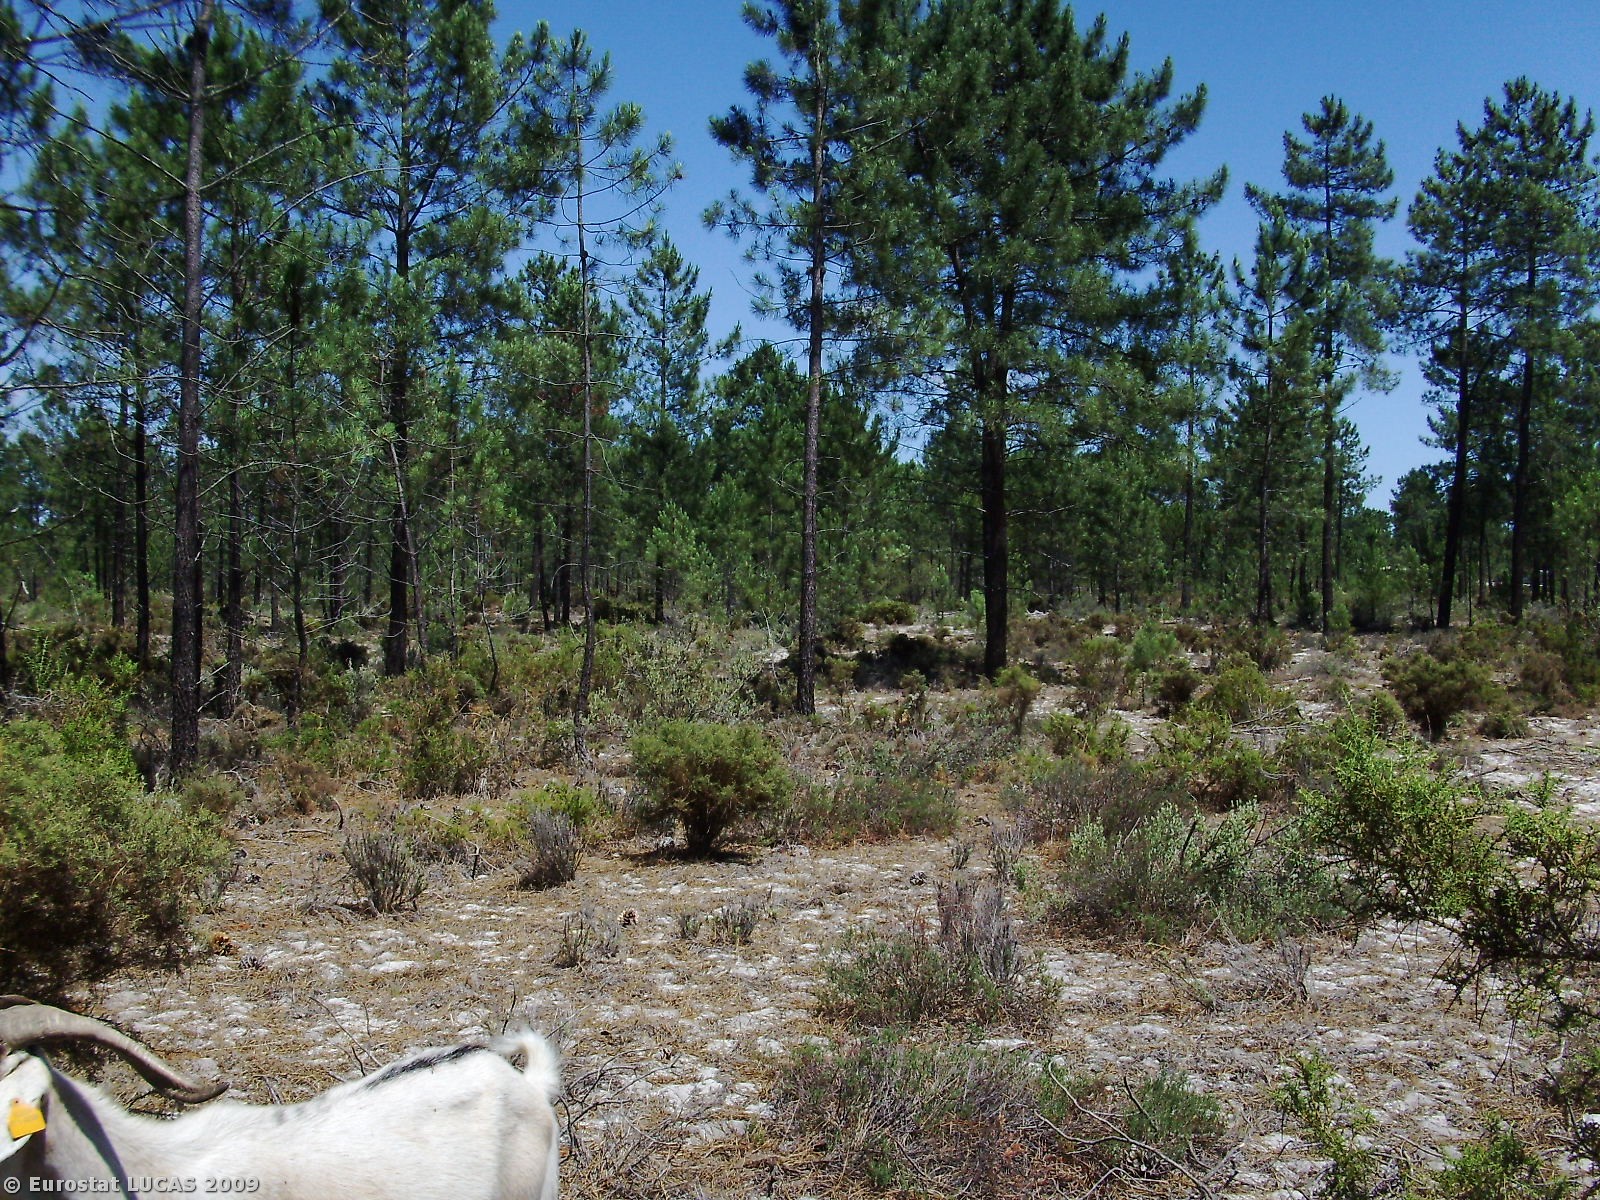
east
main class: Woodland
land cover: Coniferous woodland
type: coniferous forest of the mediterranean region
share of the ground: 50 - 75 %
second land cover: Shrubland with sparse tree cover
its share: 25 - 50 %
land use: Forestry
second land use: Agriculture (excluding fallow land and kitchen gardens)
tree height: > 5 m
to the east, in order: Coniferous woodland; Shrubland with sparse tree cover; Coniferous woodland; Shrubland with sparse tree cover
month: June
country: PT
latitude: 38.2757
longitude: -8.6507
